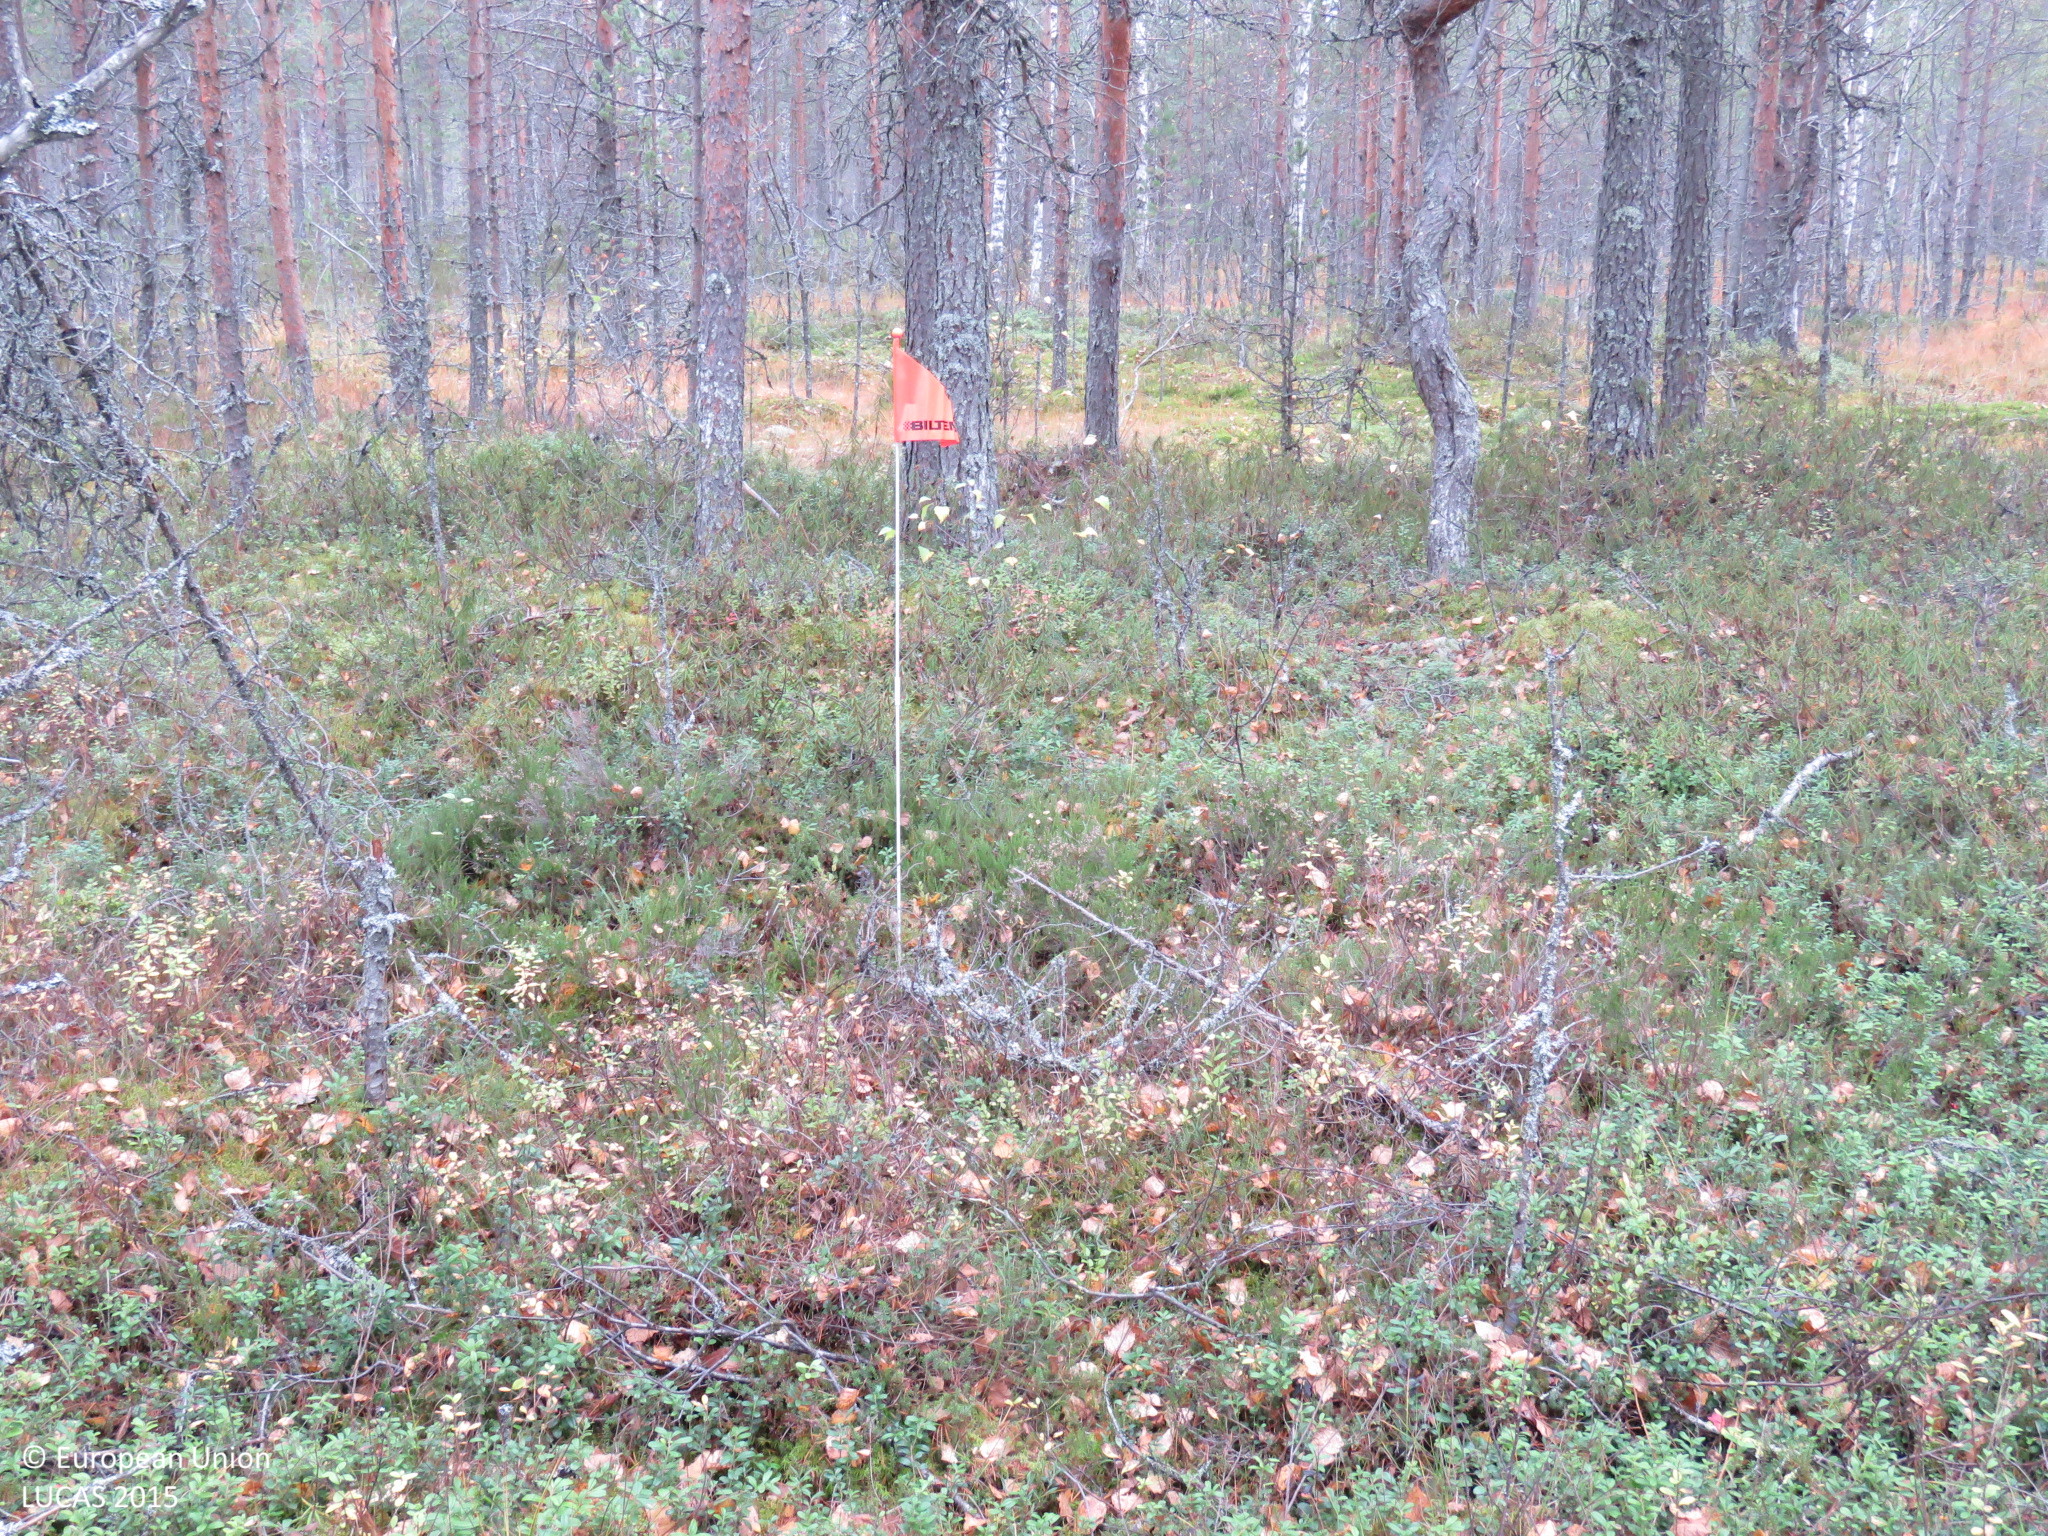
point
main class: Woodland
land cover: Pine dominated coniferous woodland
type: boreal forest
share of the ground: 50 - 75 %
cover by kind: coniferous forest trees 55 %, shrubs 25 %, broadleaved forest trees 15 %, lichens and mosses 5 %
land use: Forestry
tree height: > 5 m
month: September
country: FI
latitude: 64.9045
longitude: 27.3118
